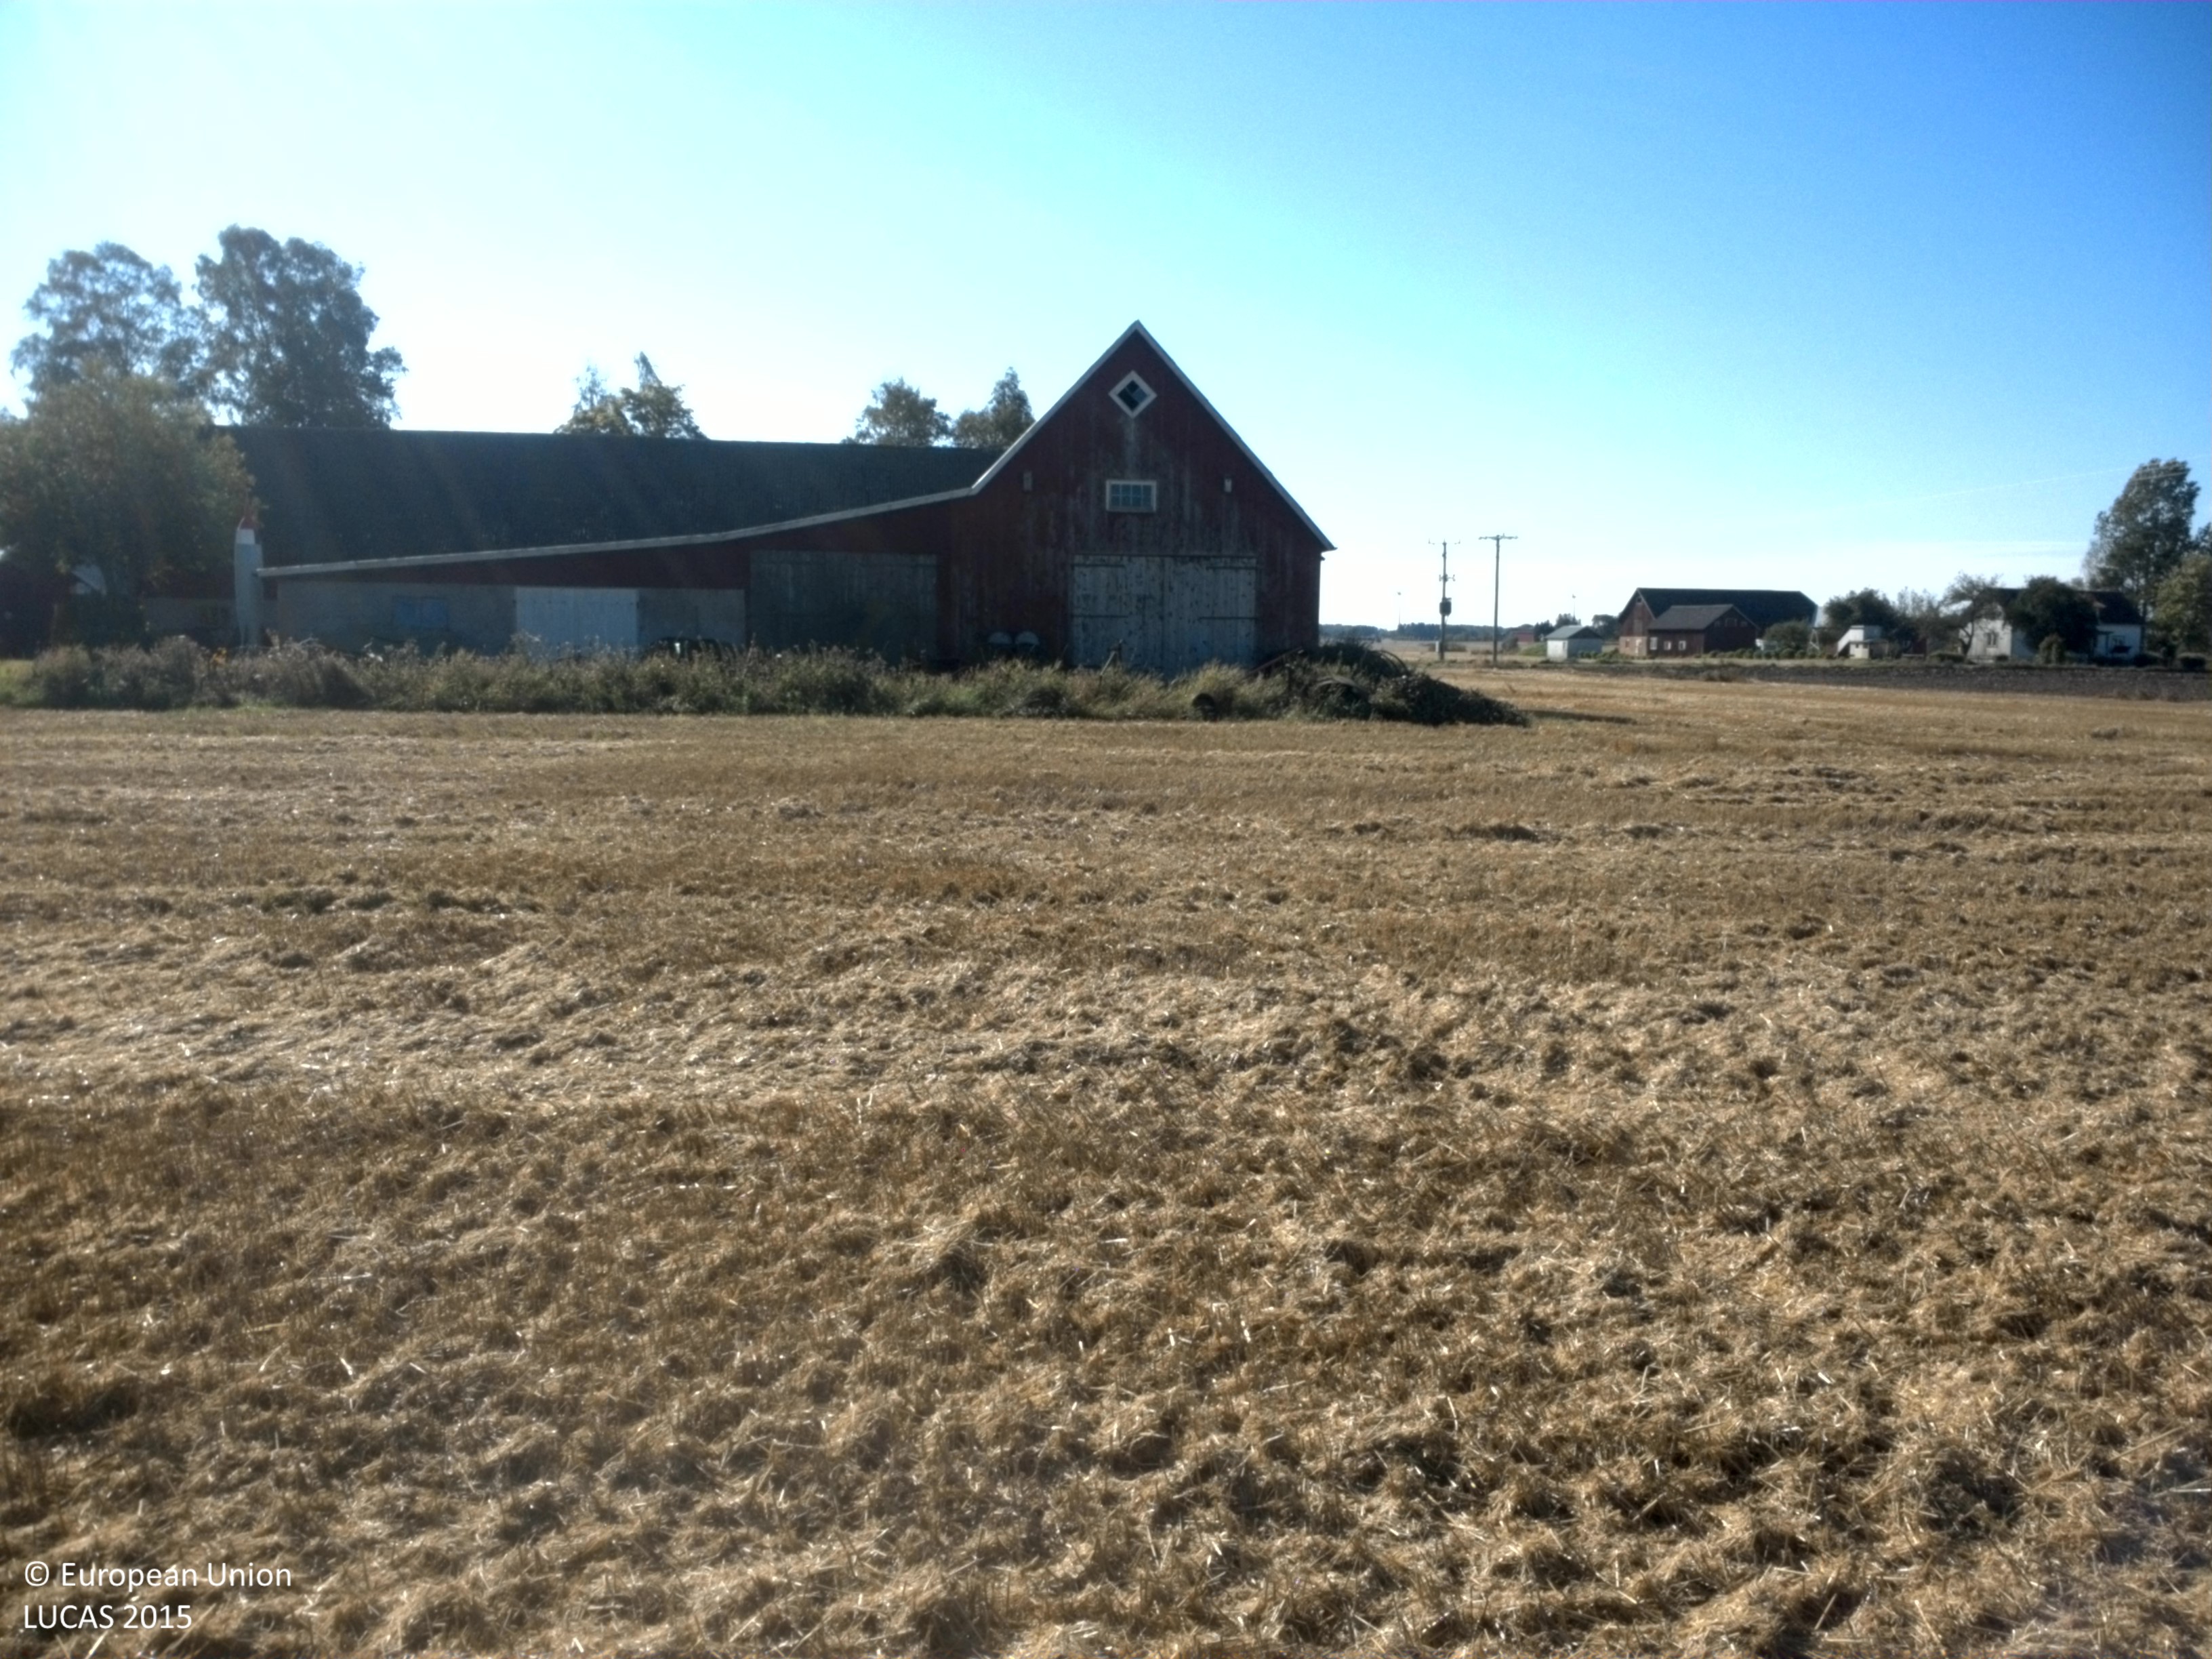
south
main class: Cropland
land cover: Common wheat
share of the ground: 50 - 75 %
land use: Agriculture (excluding fallow land and kitchen gardens)
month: September
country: SE
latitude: 58.3968
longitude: 13.2279
